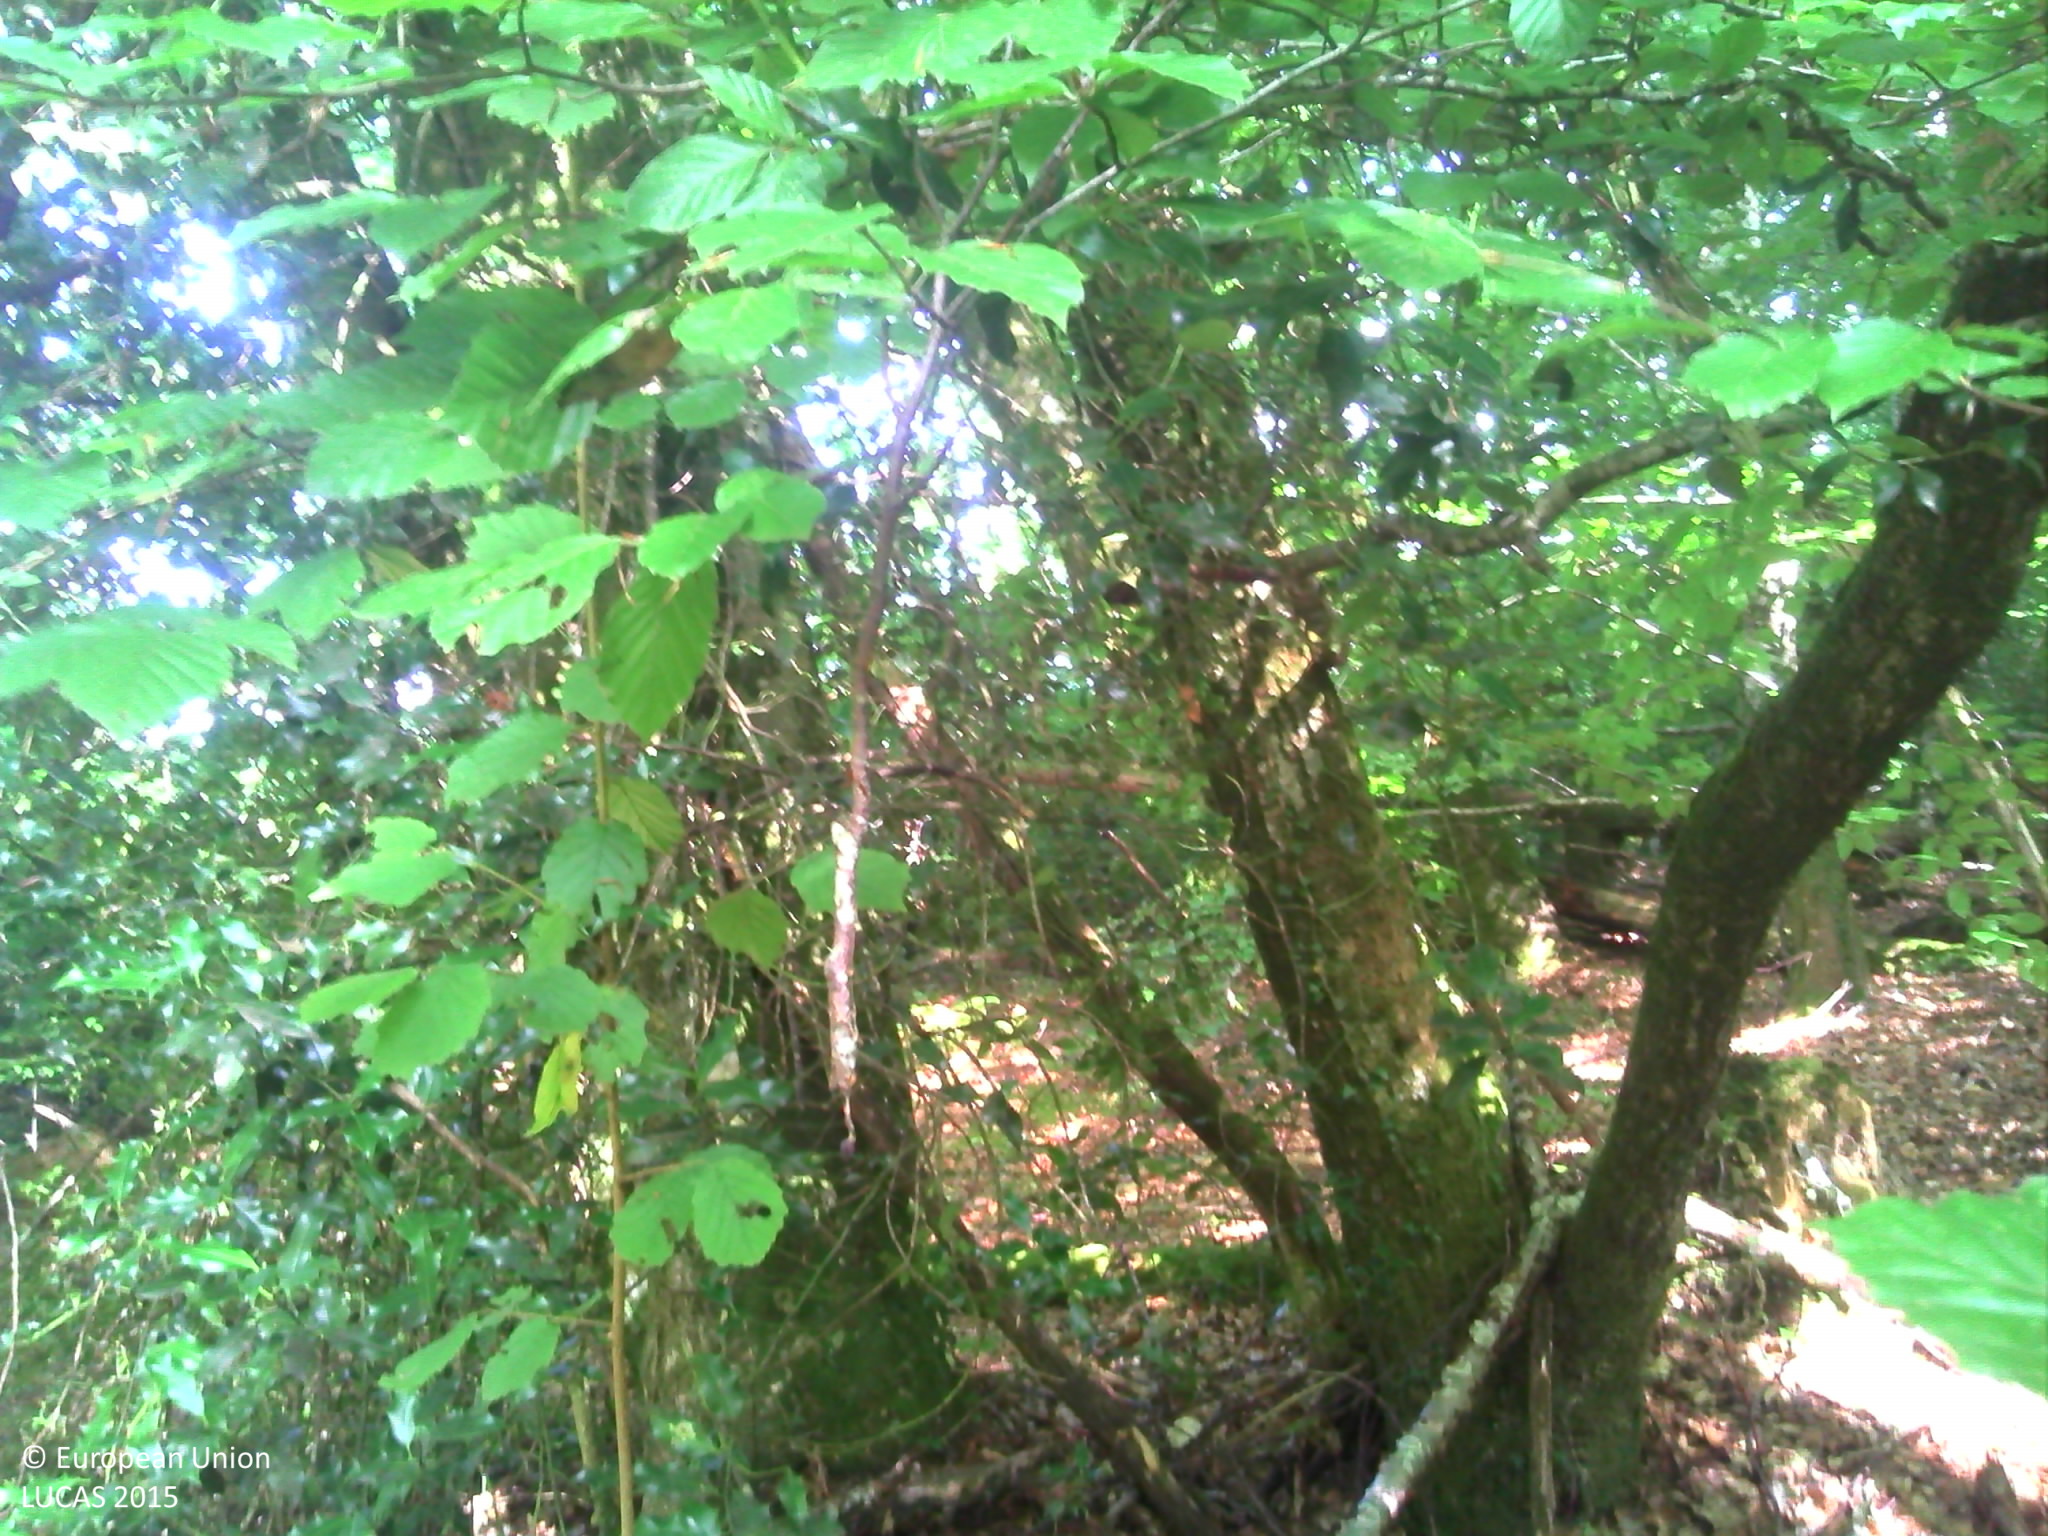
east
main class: Woodland
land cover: Broadleaved woodland
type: acidophilous oak and oak-birch forest
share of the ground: > 75 %
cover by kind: broadleaved forest trees 80 %, shrubs 10 %, herbaceous plants 5 %, lichens and mosses 5 %
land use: Forestry
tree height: > 5 m
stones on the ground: < 10 %
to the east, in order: Broadleaved woodland; Shrubland with sparse tree cover; Broadleaved woodland; Dry stone walls; Broadleaved woodland; Other bare soil; Broadleaved woodland
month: August
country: FR
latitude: 46.1067
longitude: 1.7776
